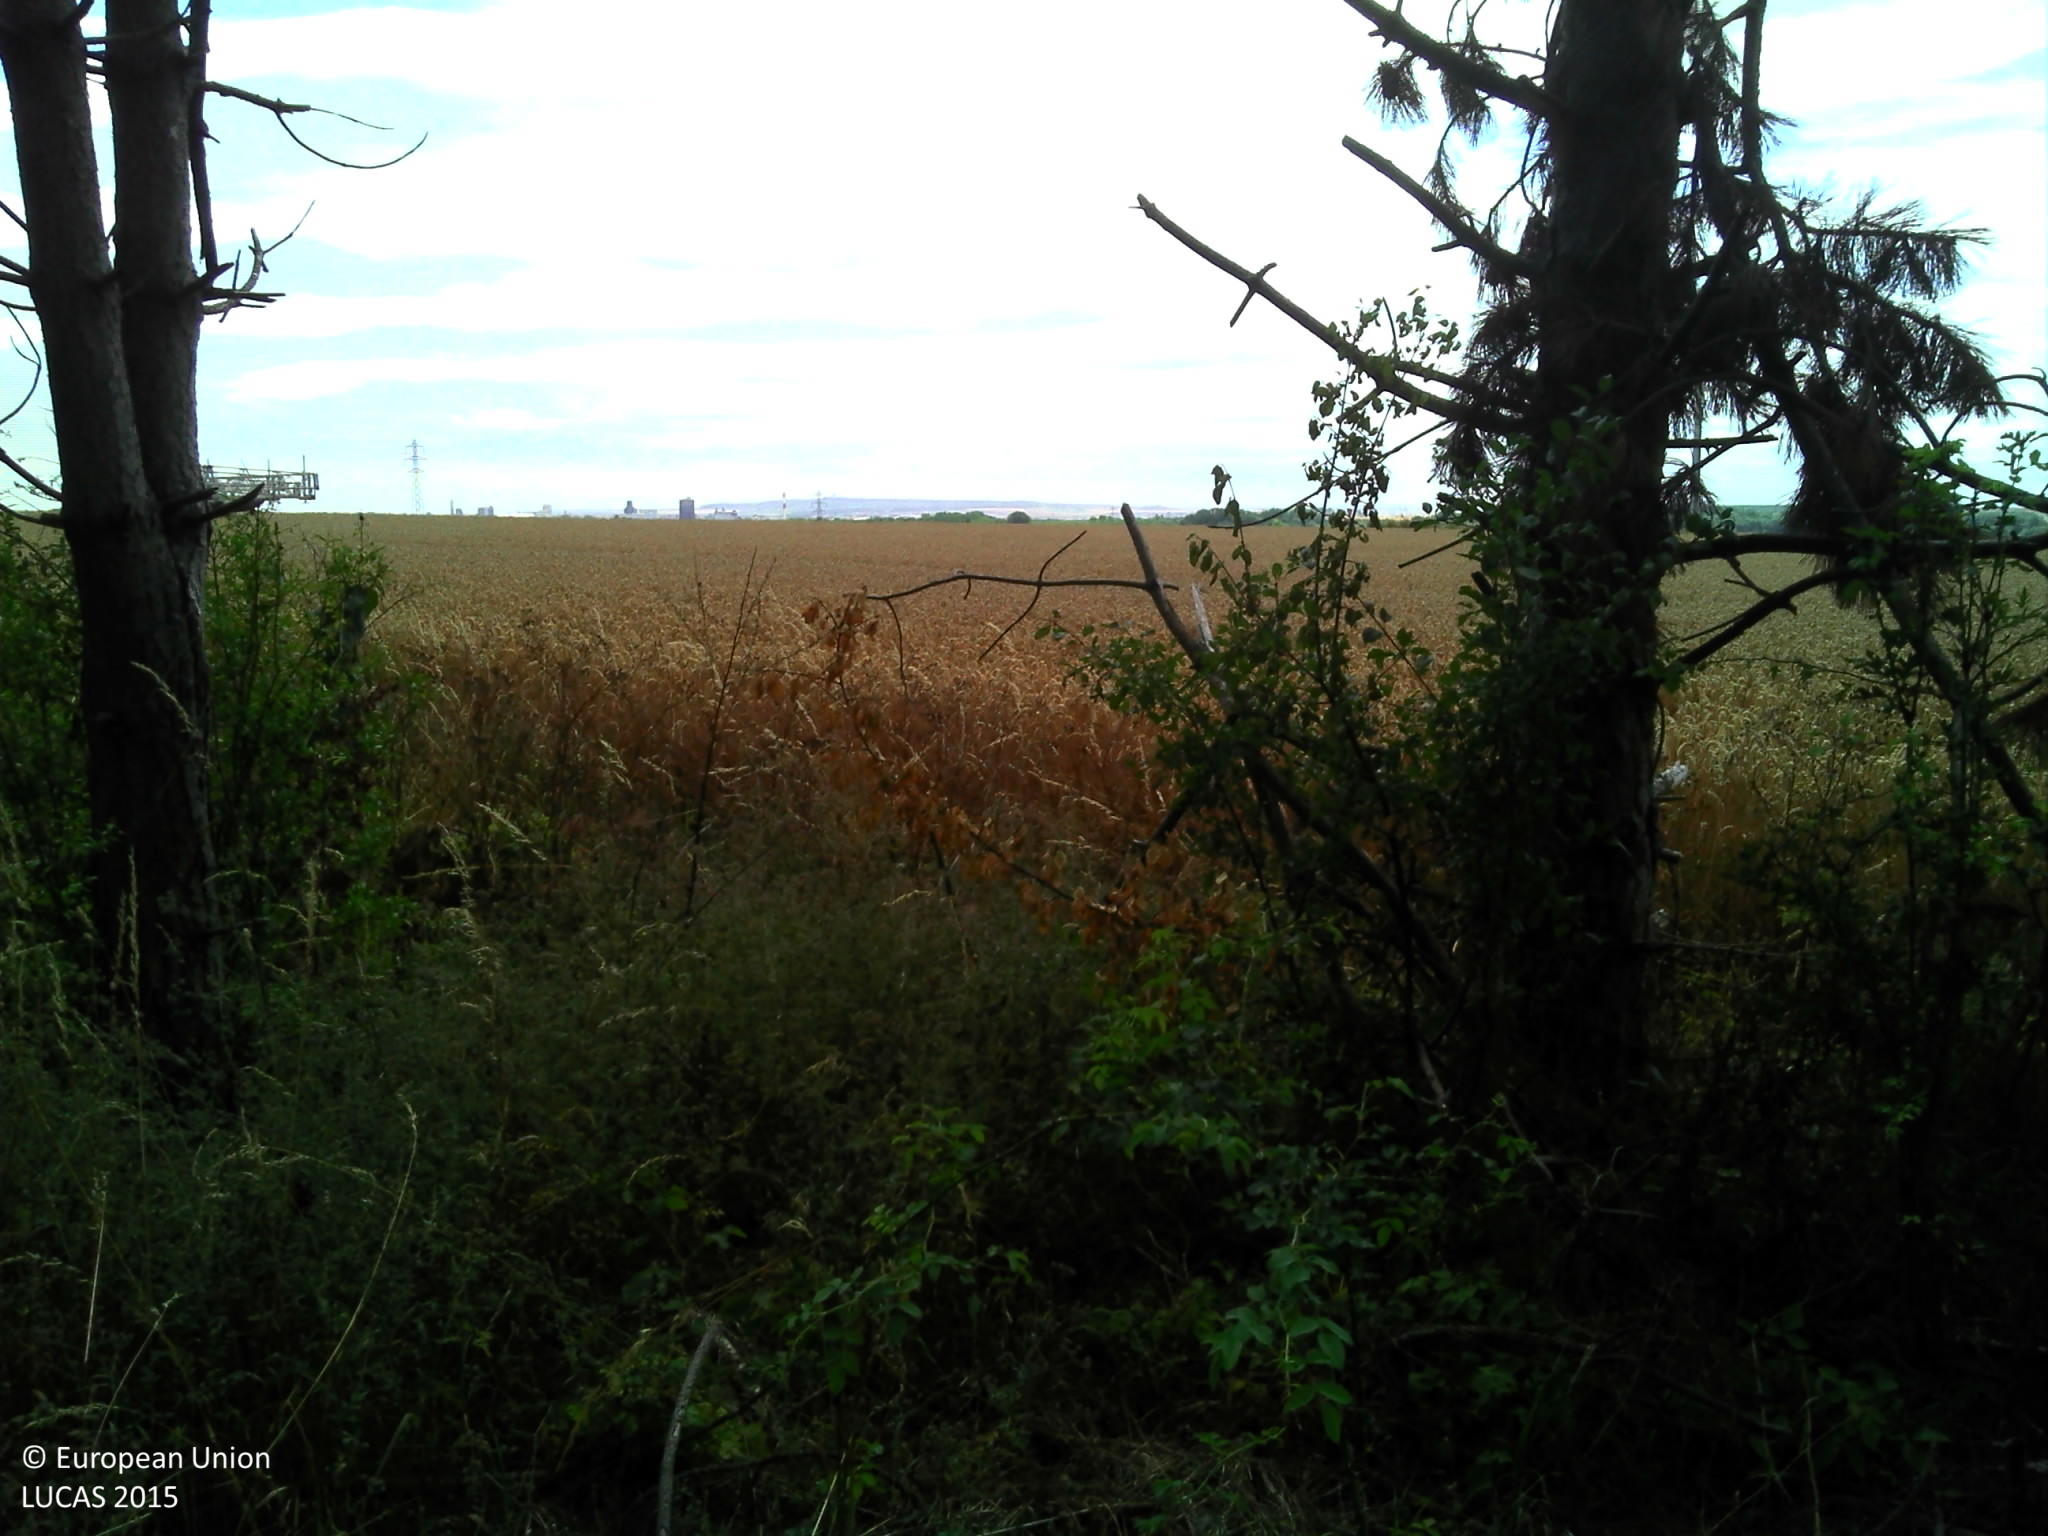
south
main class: Woodland
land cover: Pine dominated coniferous woodland
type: boreal forest
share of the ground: > 75 %
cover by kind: coniferous forest trees 60 %, herbaceous plants 30 %, lichens and mosses 5 %, unconsolidated bare surface 5 %
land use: Forestry
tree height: > 5 m
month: July
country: FR
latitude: 49.3859
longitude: 4.1681
